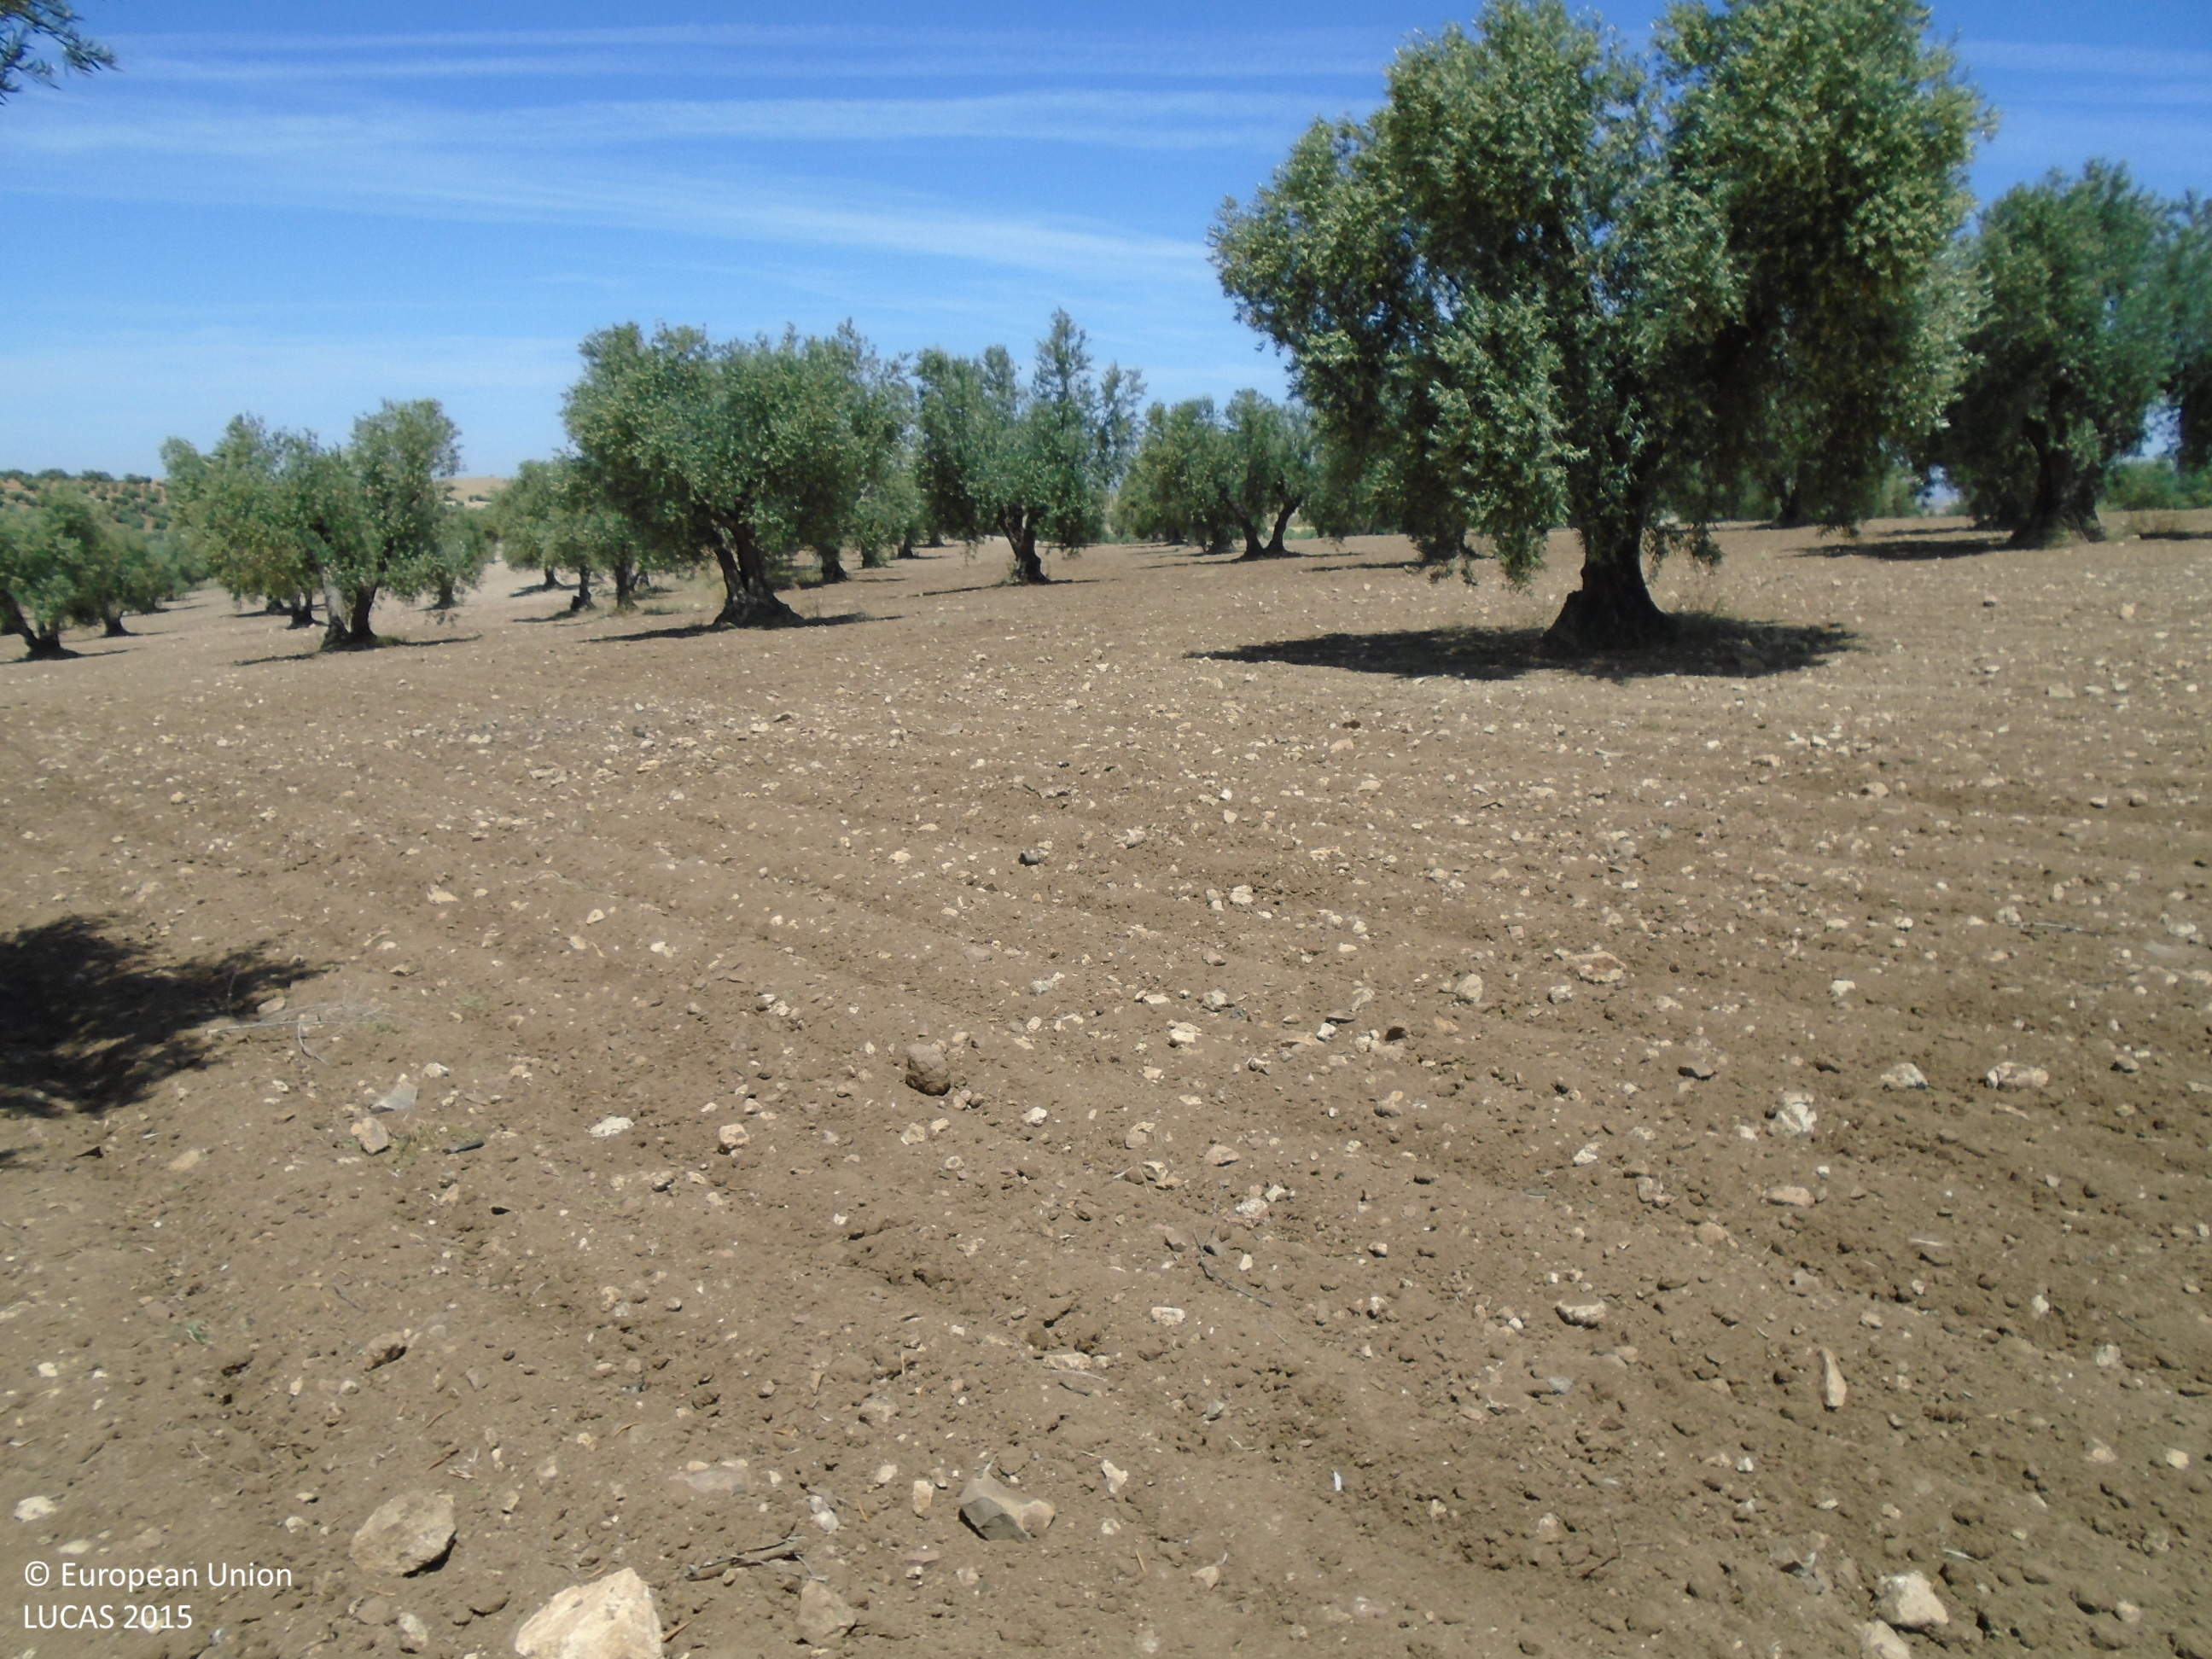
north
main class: Cropland
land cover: Olive groves
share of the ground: 10 - 25 %
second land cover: Other bare soil
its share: > 75 %
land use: Agriculture (excluding fallow land and kitchen gardens)
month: May
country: ES
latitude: 39.7822
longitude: -3.7966
